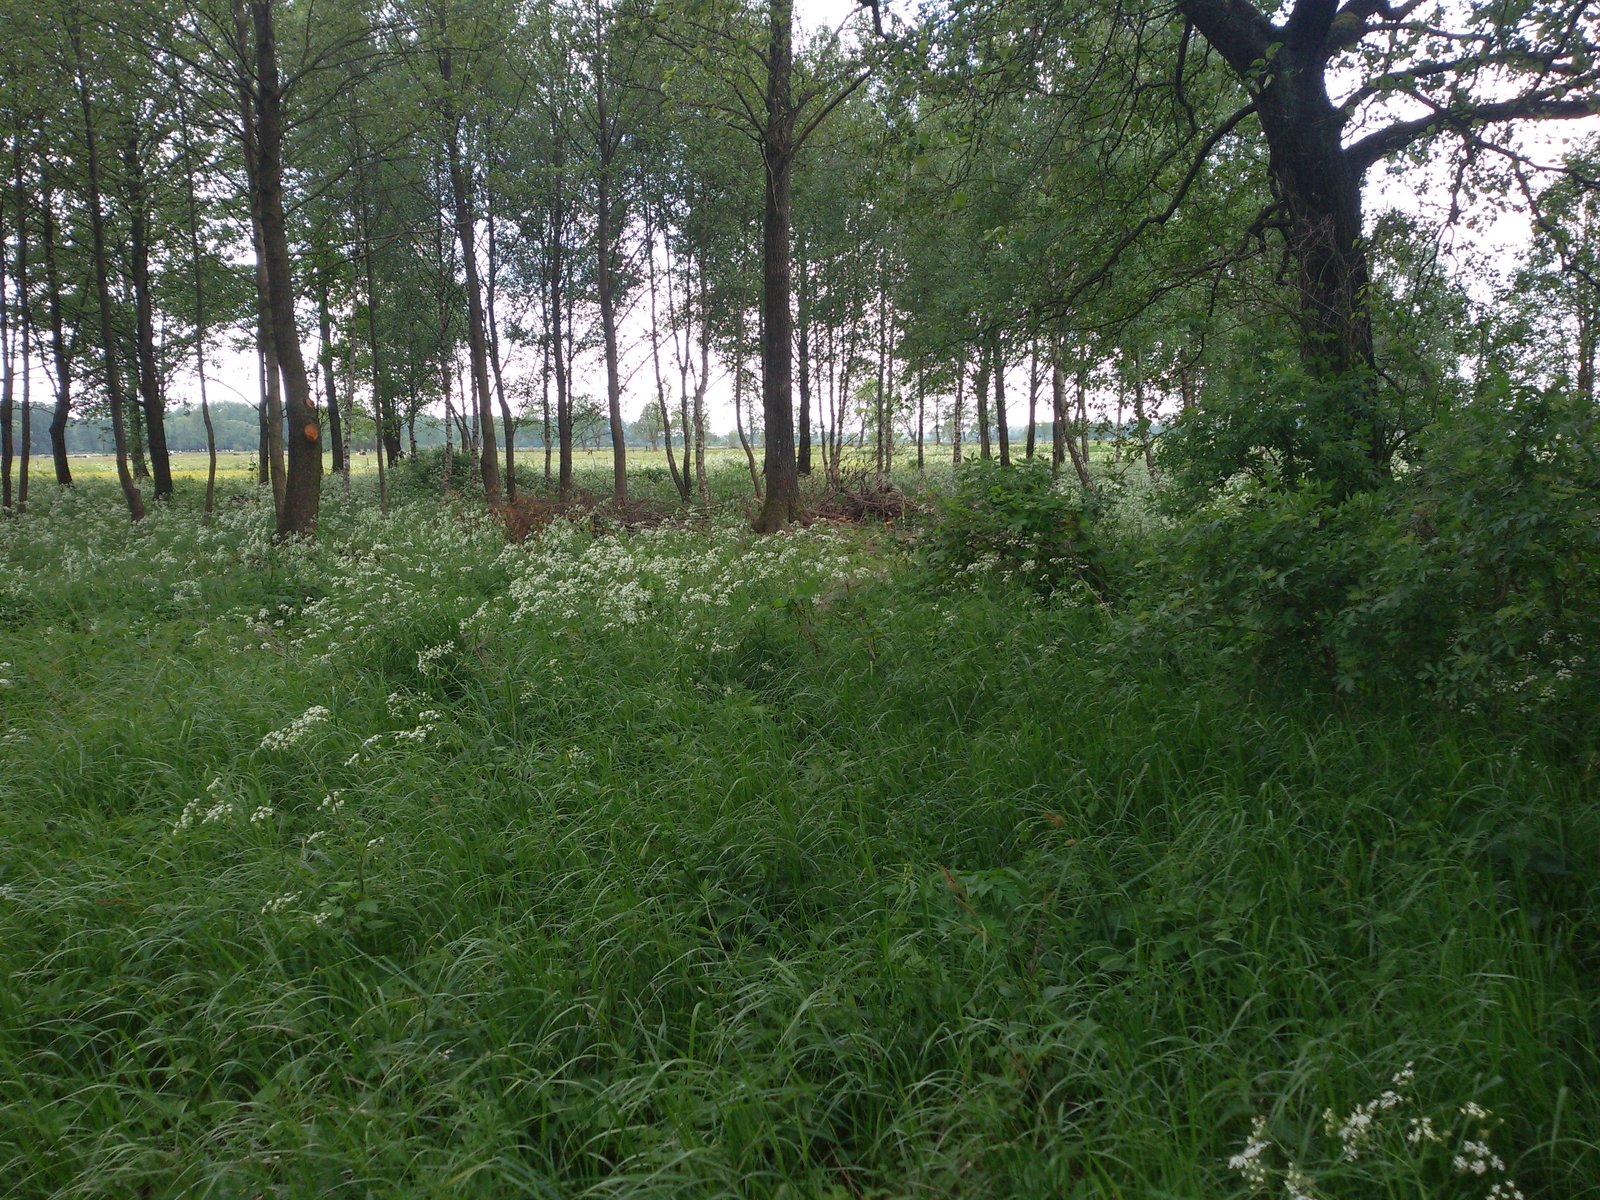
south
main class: Woodland
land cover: Broadleaved woodland
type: mesophytic deciduous forest
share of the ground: 50 - 75 %
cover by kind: broadleaved forest trees 50 %, herbaceous plants 40 %, shrubs 10 %
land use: Forestry
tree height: > 5 m
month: May
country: PL
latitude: 53.4420
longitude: 21.0187
